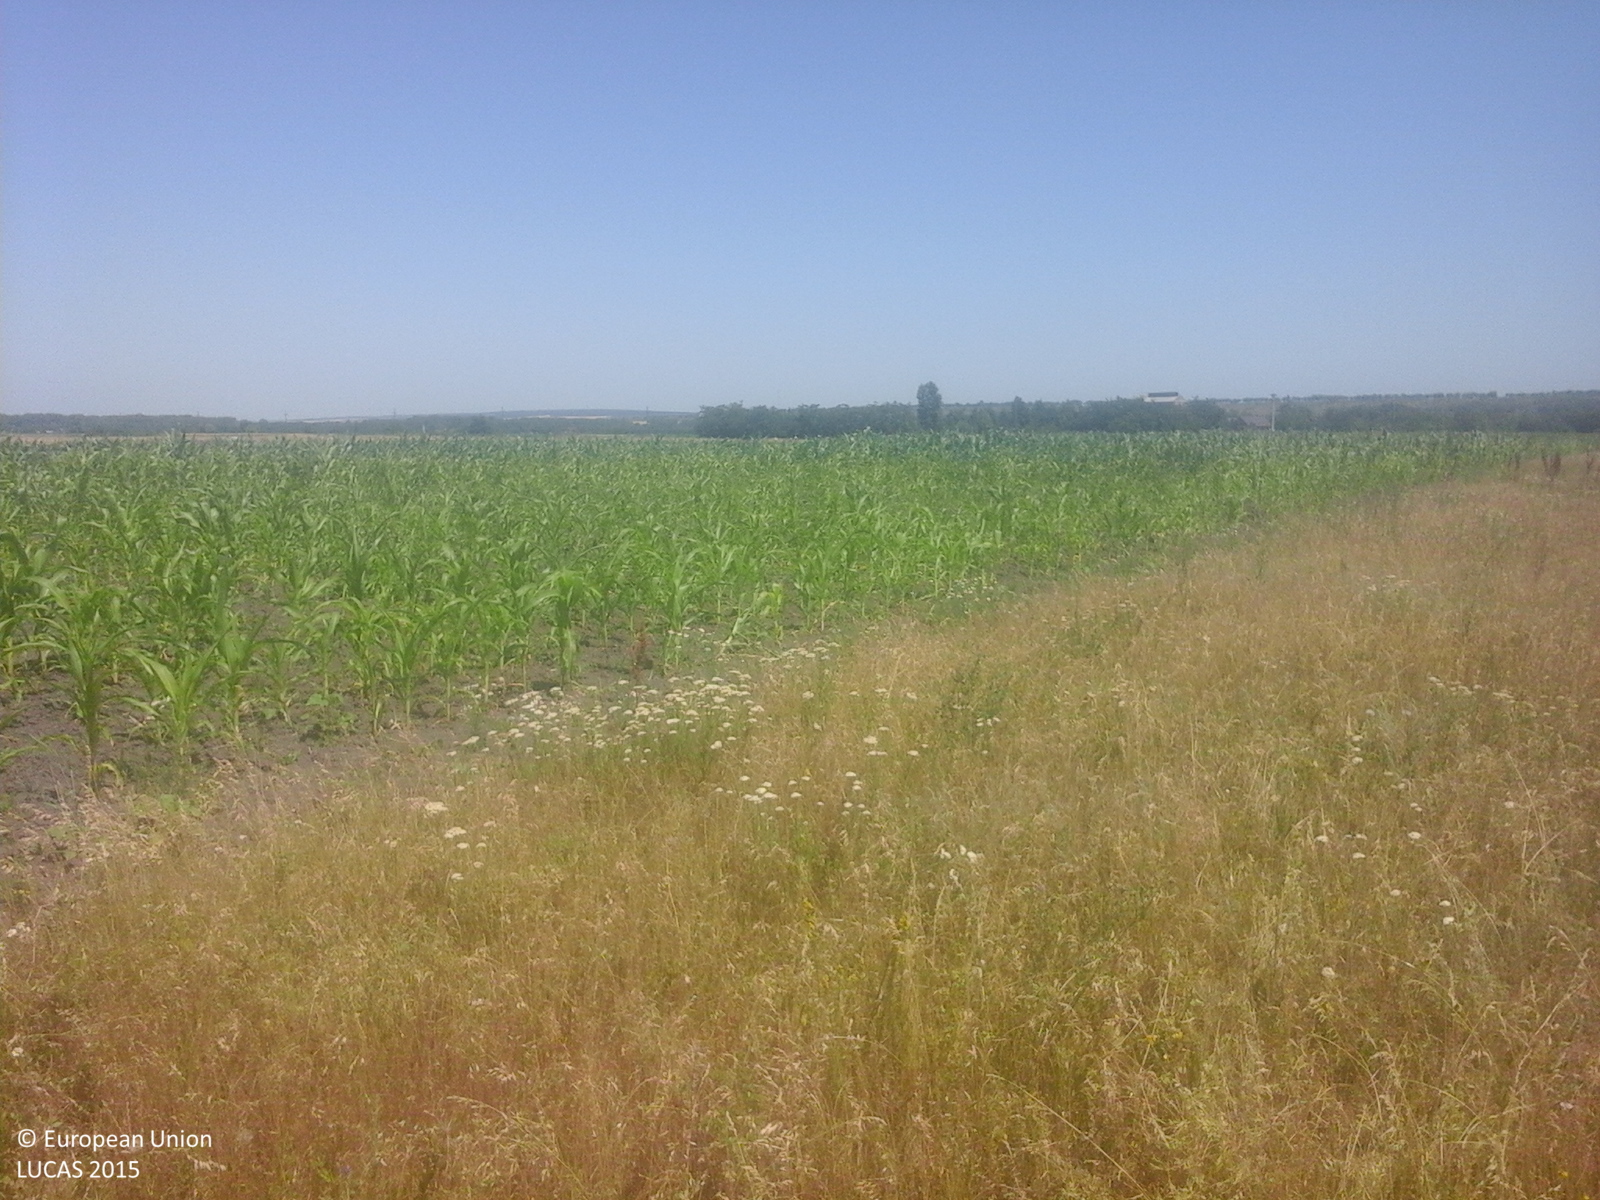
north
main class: Grassland
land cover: Grassland without tree/shrub cover
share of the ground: > 75 %
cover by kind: herbaceous plants 100 %
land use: Agriculture (excluding fallow land and kitchen gardens)
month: June
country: RO
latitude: 47.0793
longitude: 27.8676
